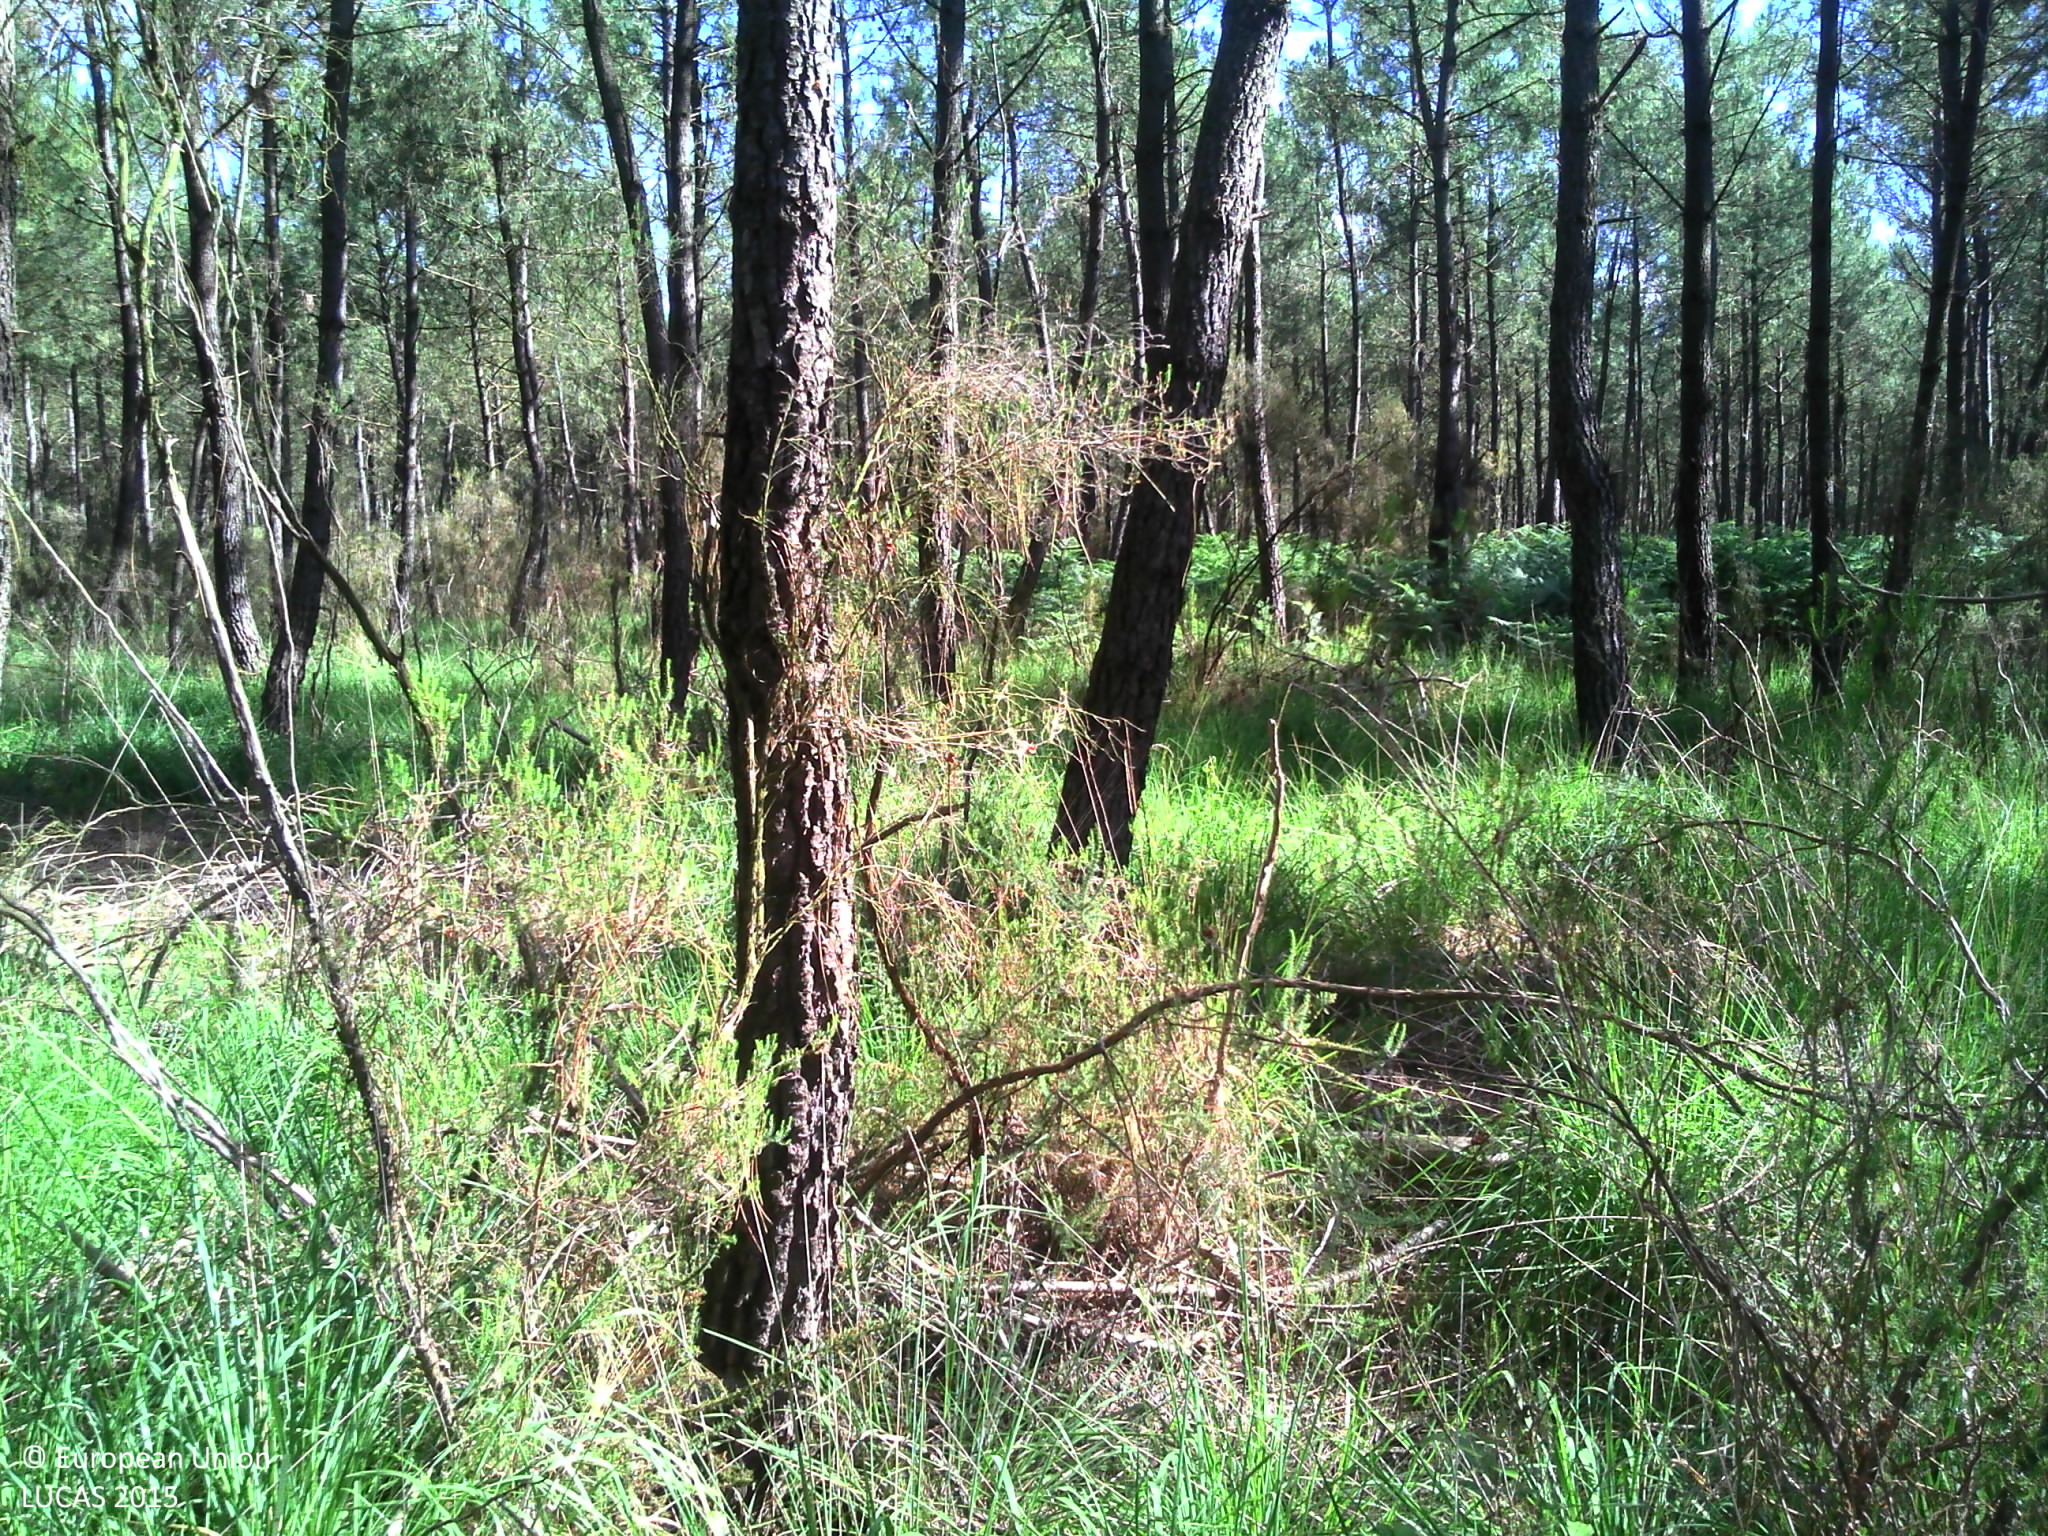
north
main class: Woodland
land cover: Pine dominated coniferous woodland
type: boreal forest
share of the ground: > 75 %
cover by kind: coniferous forest trees 85 %, herbaceous plants 10 %, shrubs 5 %
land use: Forestry
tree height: > 5 m
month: June
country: FR
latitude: 46.6891
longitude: 0.5020
